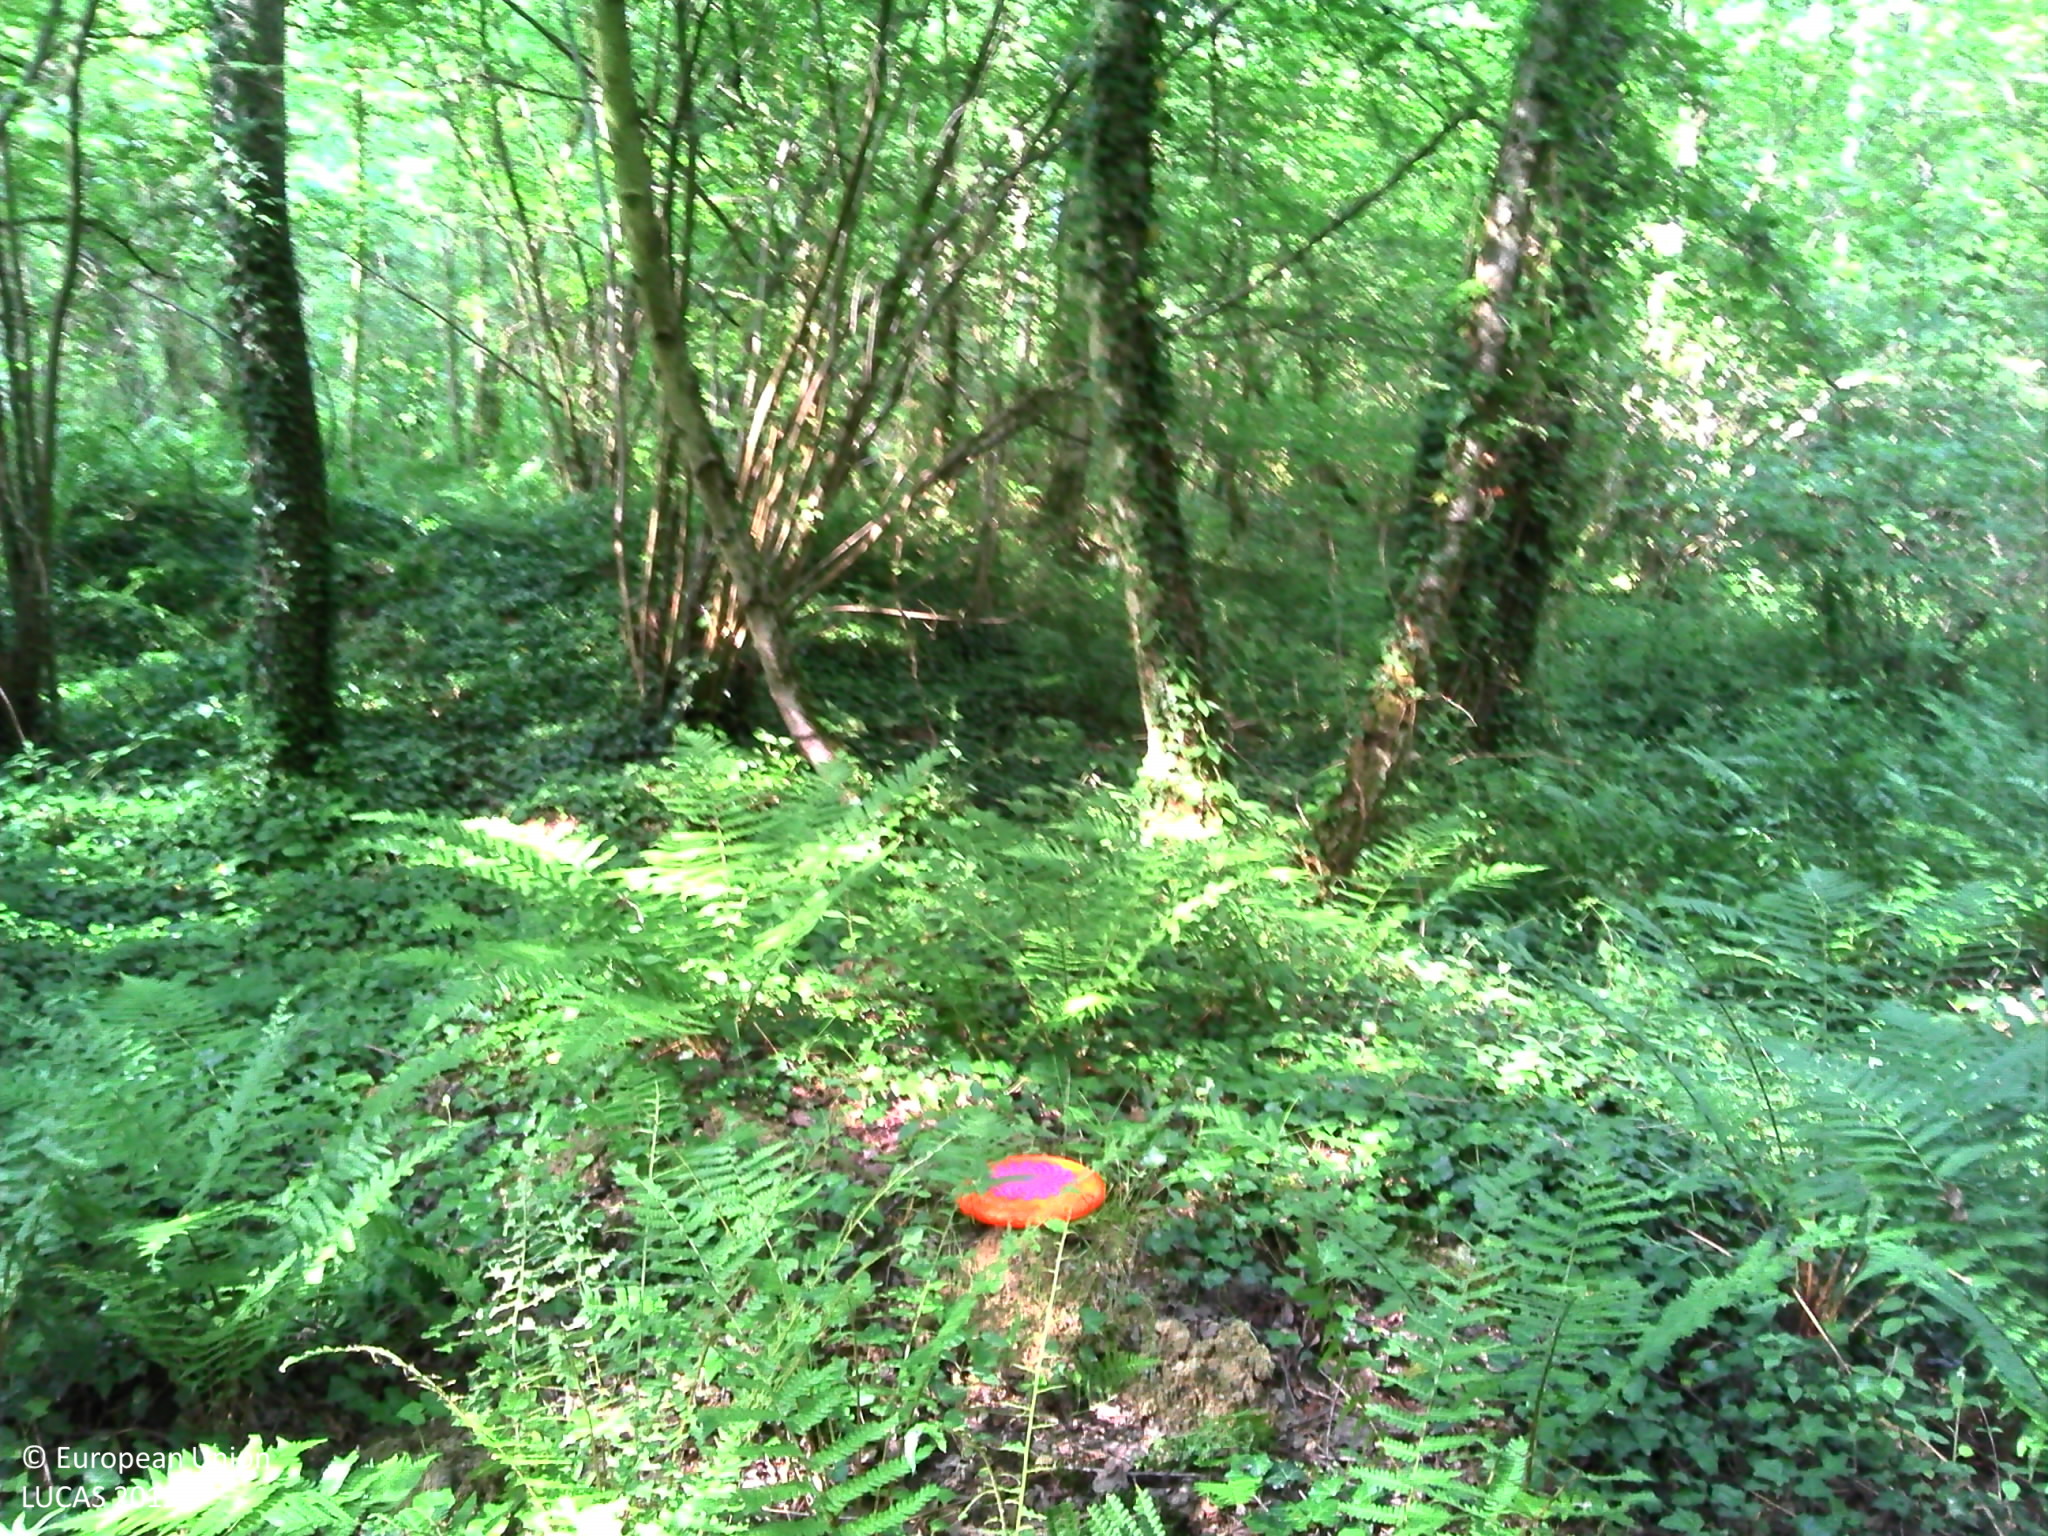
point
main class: Woodland
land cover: Broadleaved woodland
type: mesophytic deciduous forest
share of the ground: > 75 %
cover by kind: broadleaved forest trees 80 %, herbaceous plants 20 %
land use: Forestry
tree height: > 5 m
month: June
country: FR
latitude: 45.9245
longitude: 4.9356
